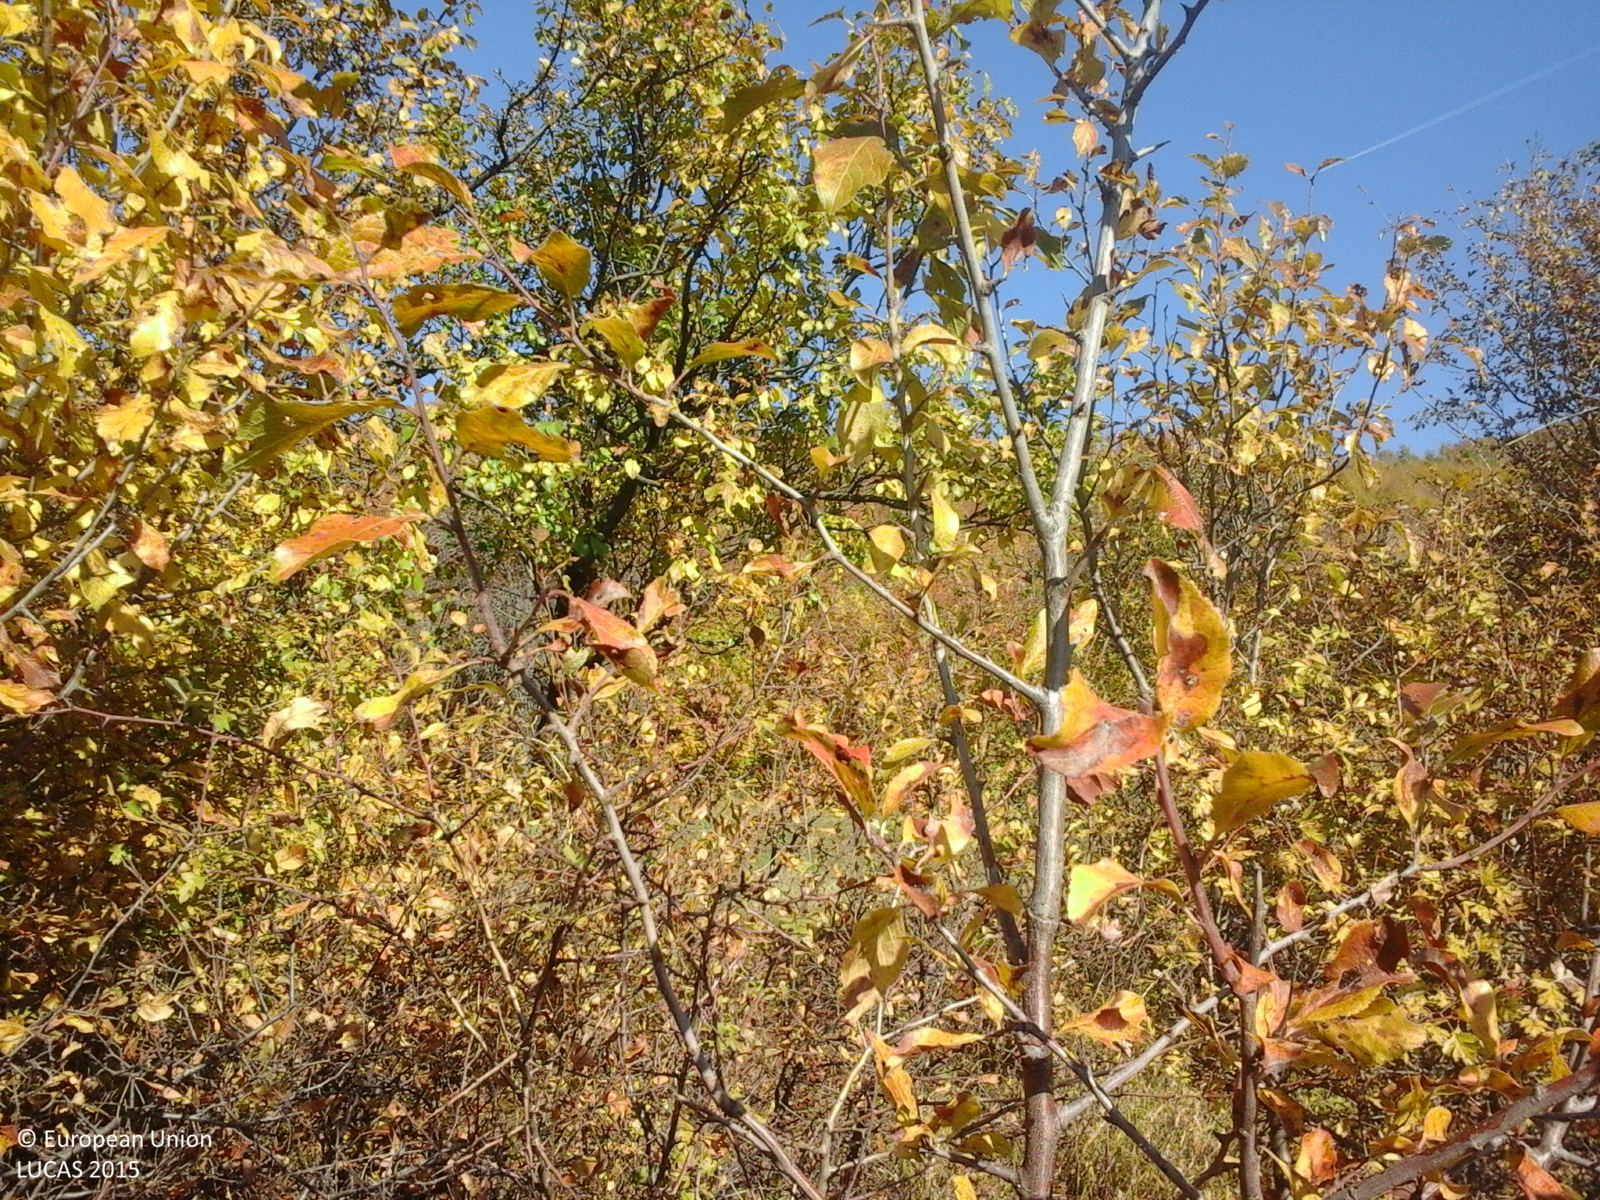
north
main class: Shrubland
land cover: Shrubland without tree cover
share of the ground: > 75 %
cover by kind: shrubs 100 %
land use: Fallow land
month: October
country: RO
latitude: 45.3268
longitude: 26.5454
